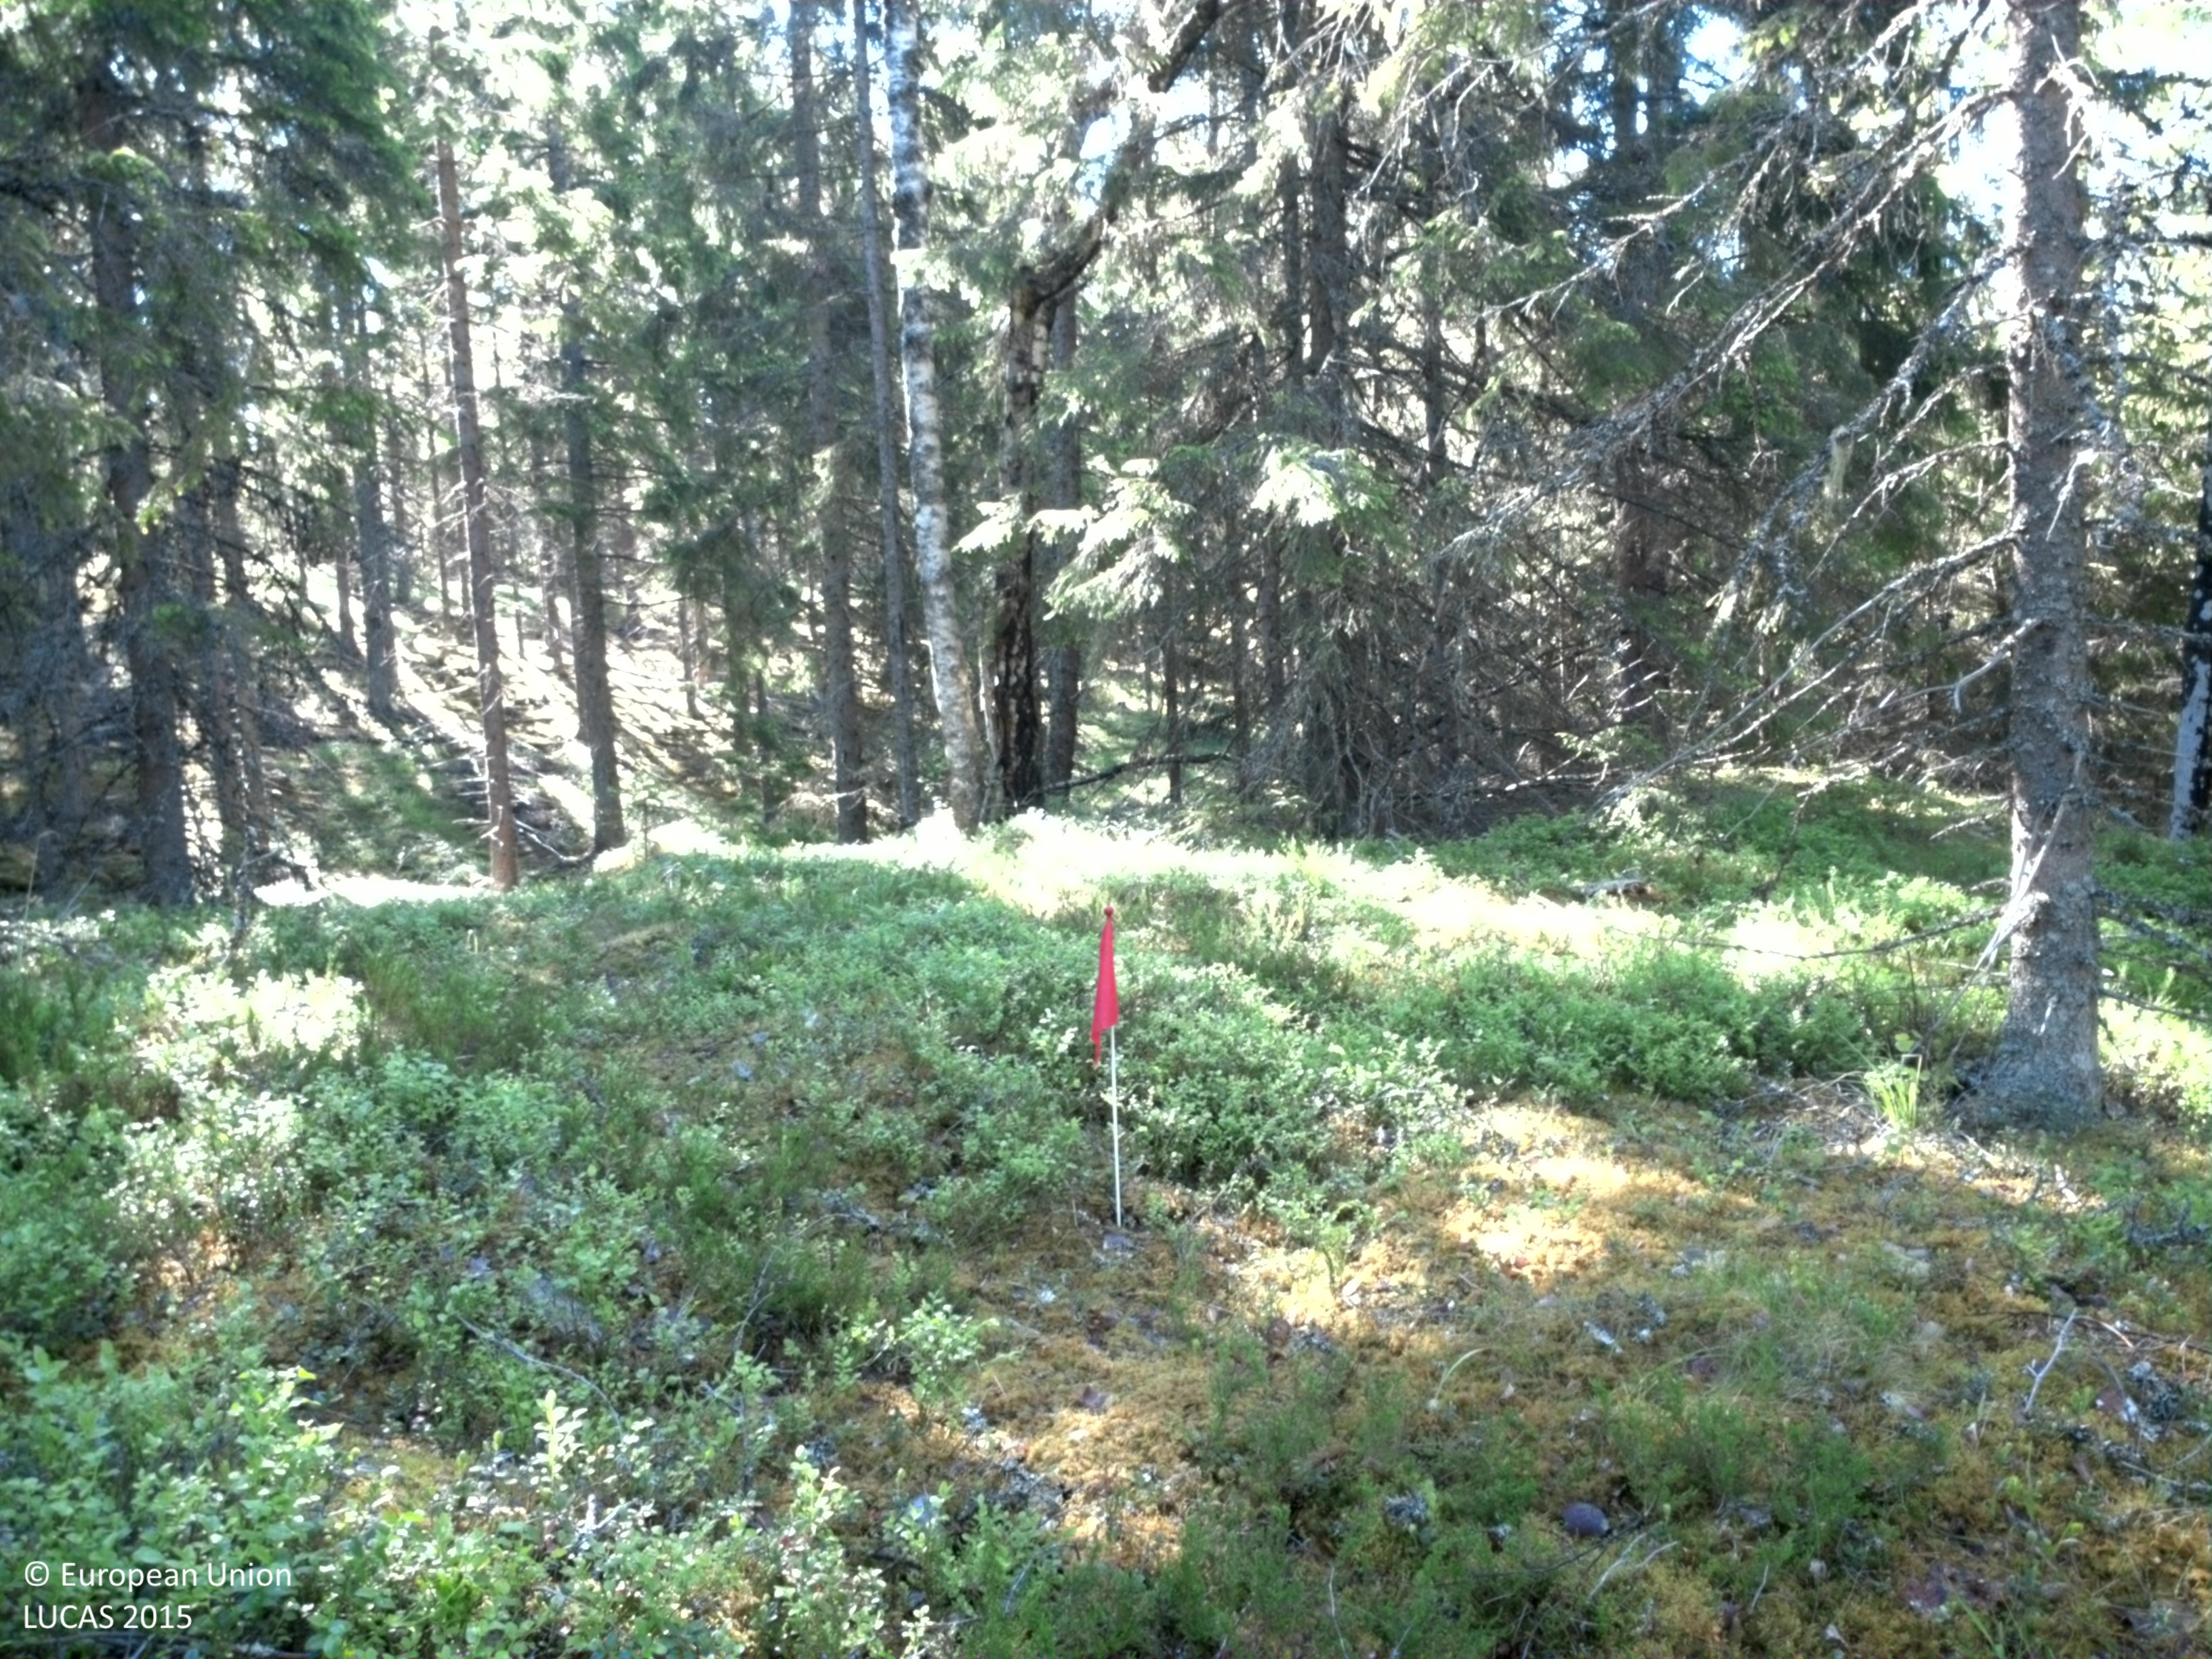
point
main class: Woodland
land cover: Spruce dominated coniferous woodland
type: boreal forest
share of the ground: > 75 %
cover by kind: coniferous forest trees 75 %, shrubs 10 %, lichens and mosses 10 %, broadleaved forest trees 5 %
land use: Forestry
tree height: > 5 m
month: June
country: SE
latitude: 59.4416
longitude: 12.3041
